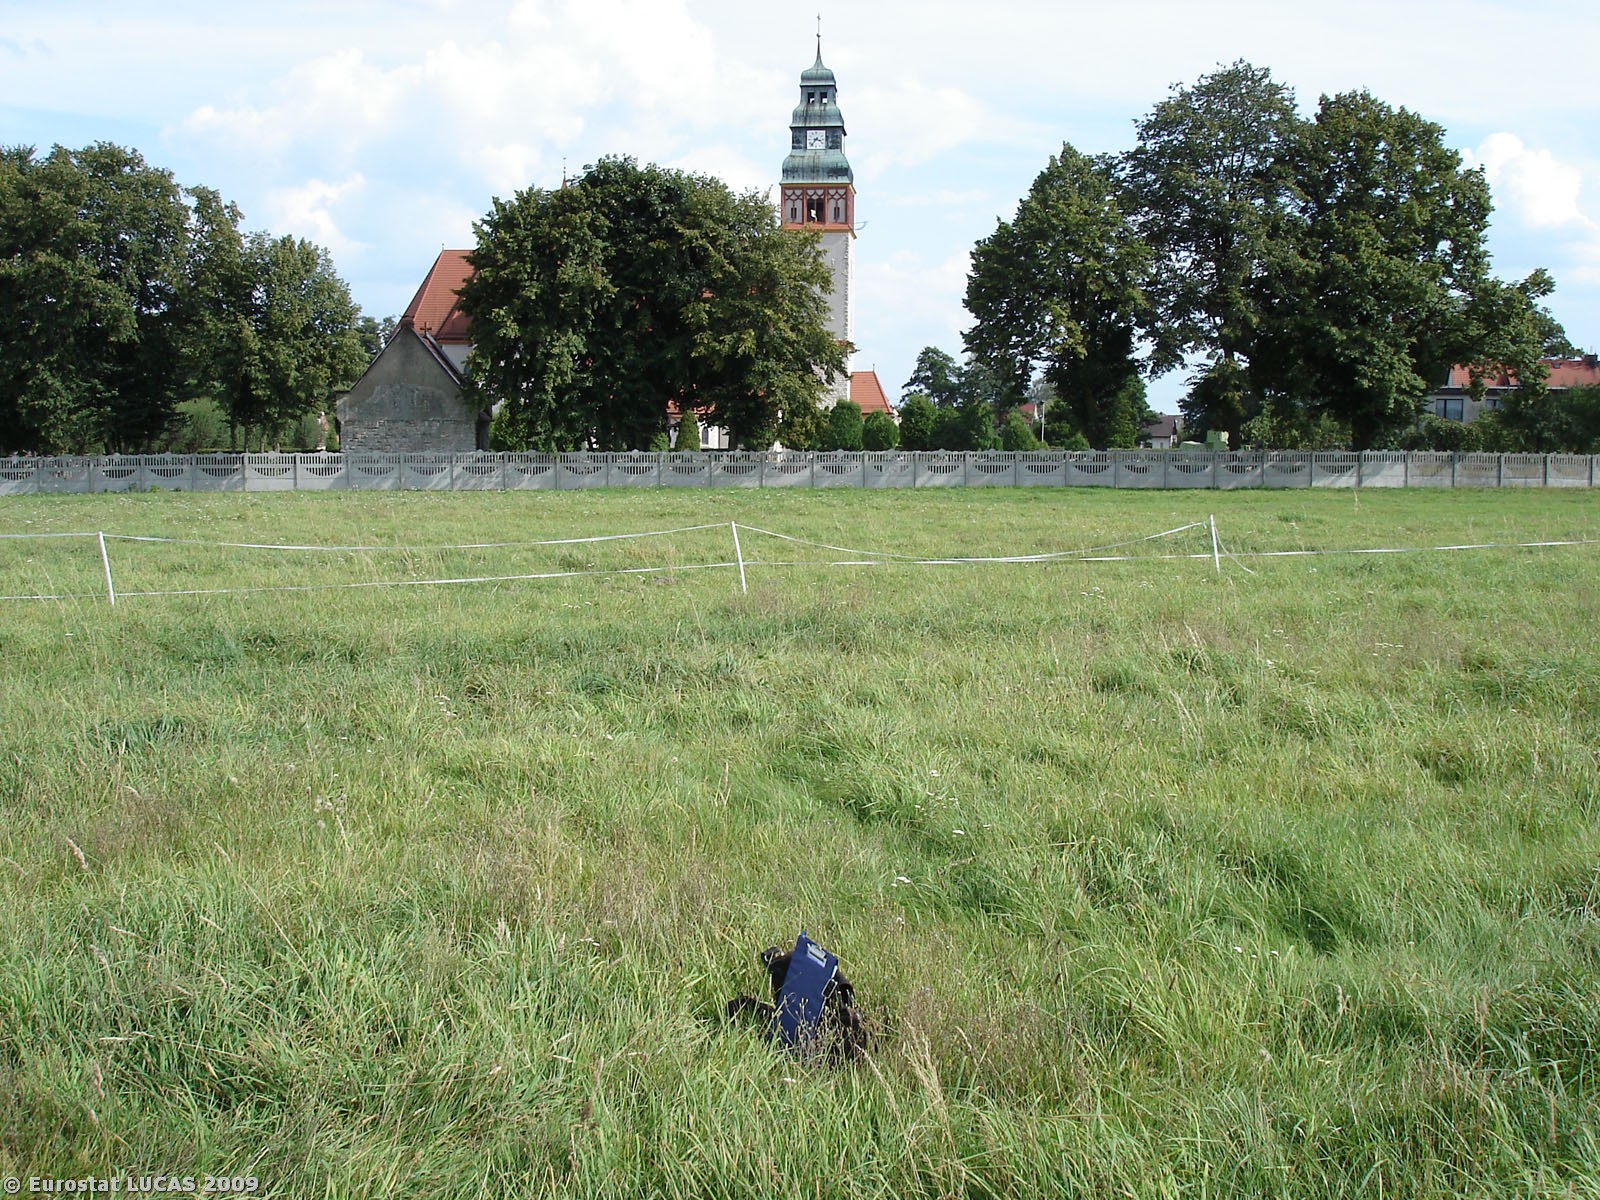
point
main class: Grassland
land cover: Grassland without tree/shrub cover
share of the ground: > 75 %
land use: Agriculture (excluding fallow land and kitchen gardens)
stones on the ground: < 10 %
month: August
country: PL
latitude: 50.7641
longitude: 18.3405
